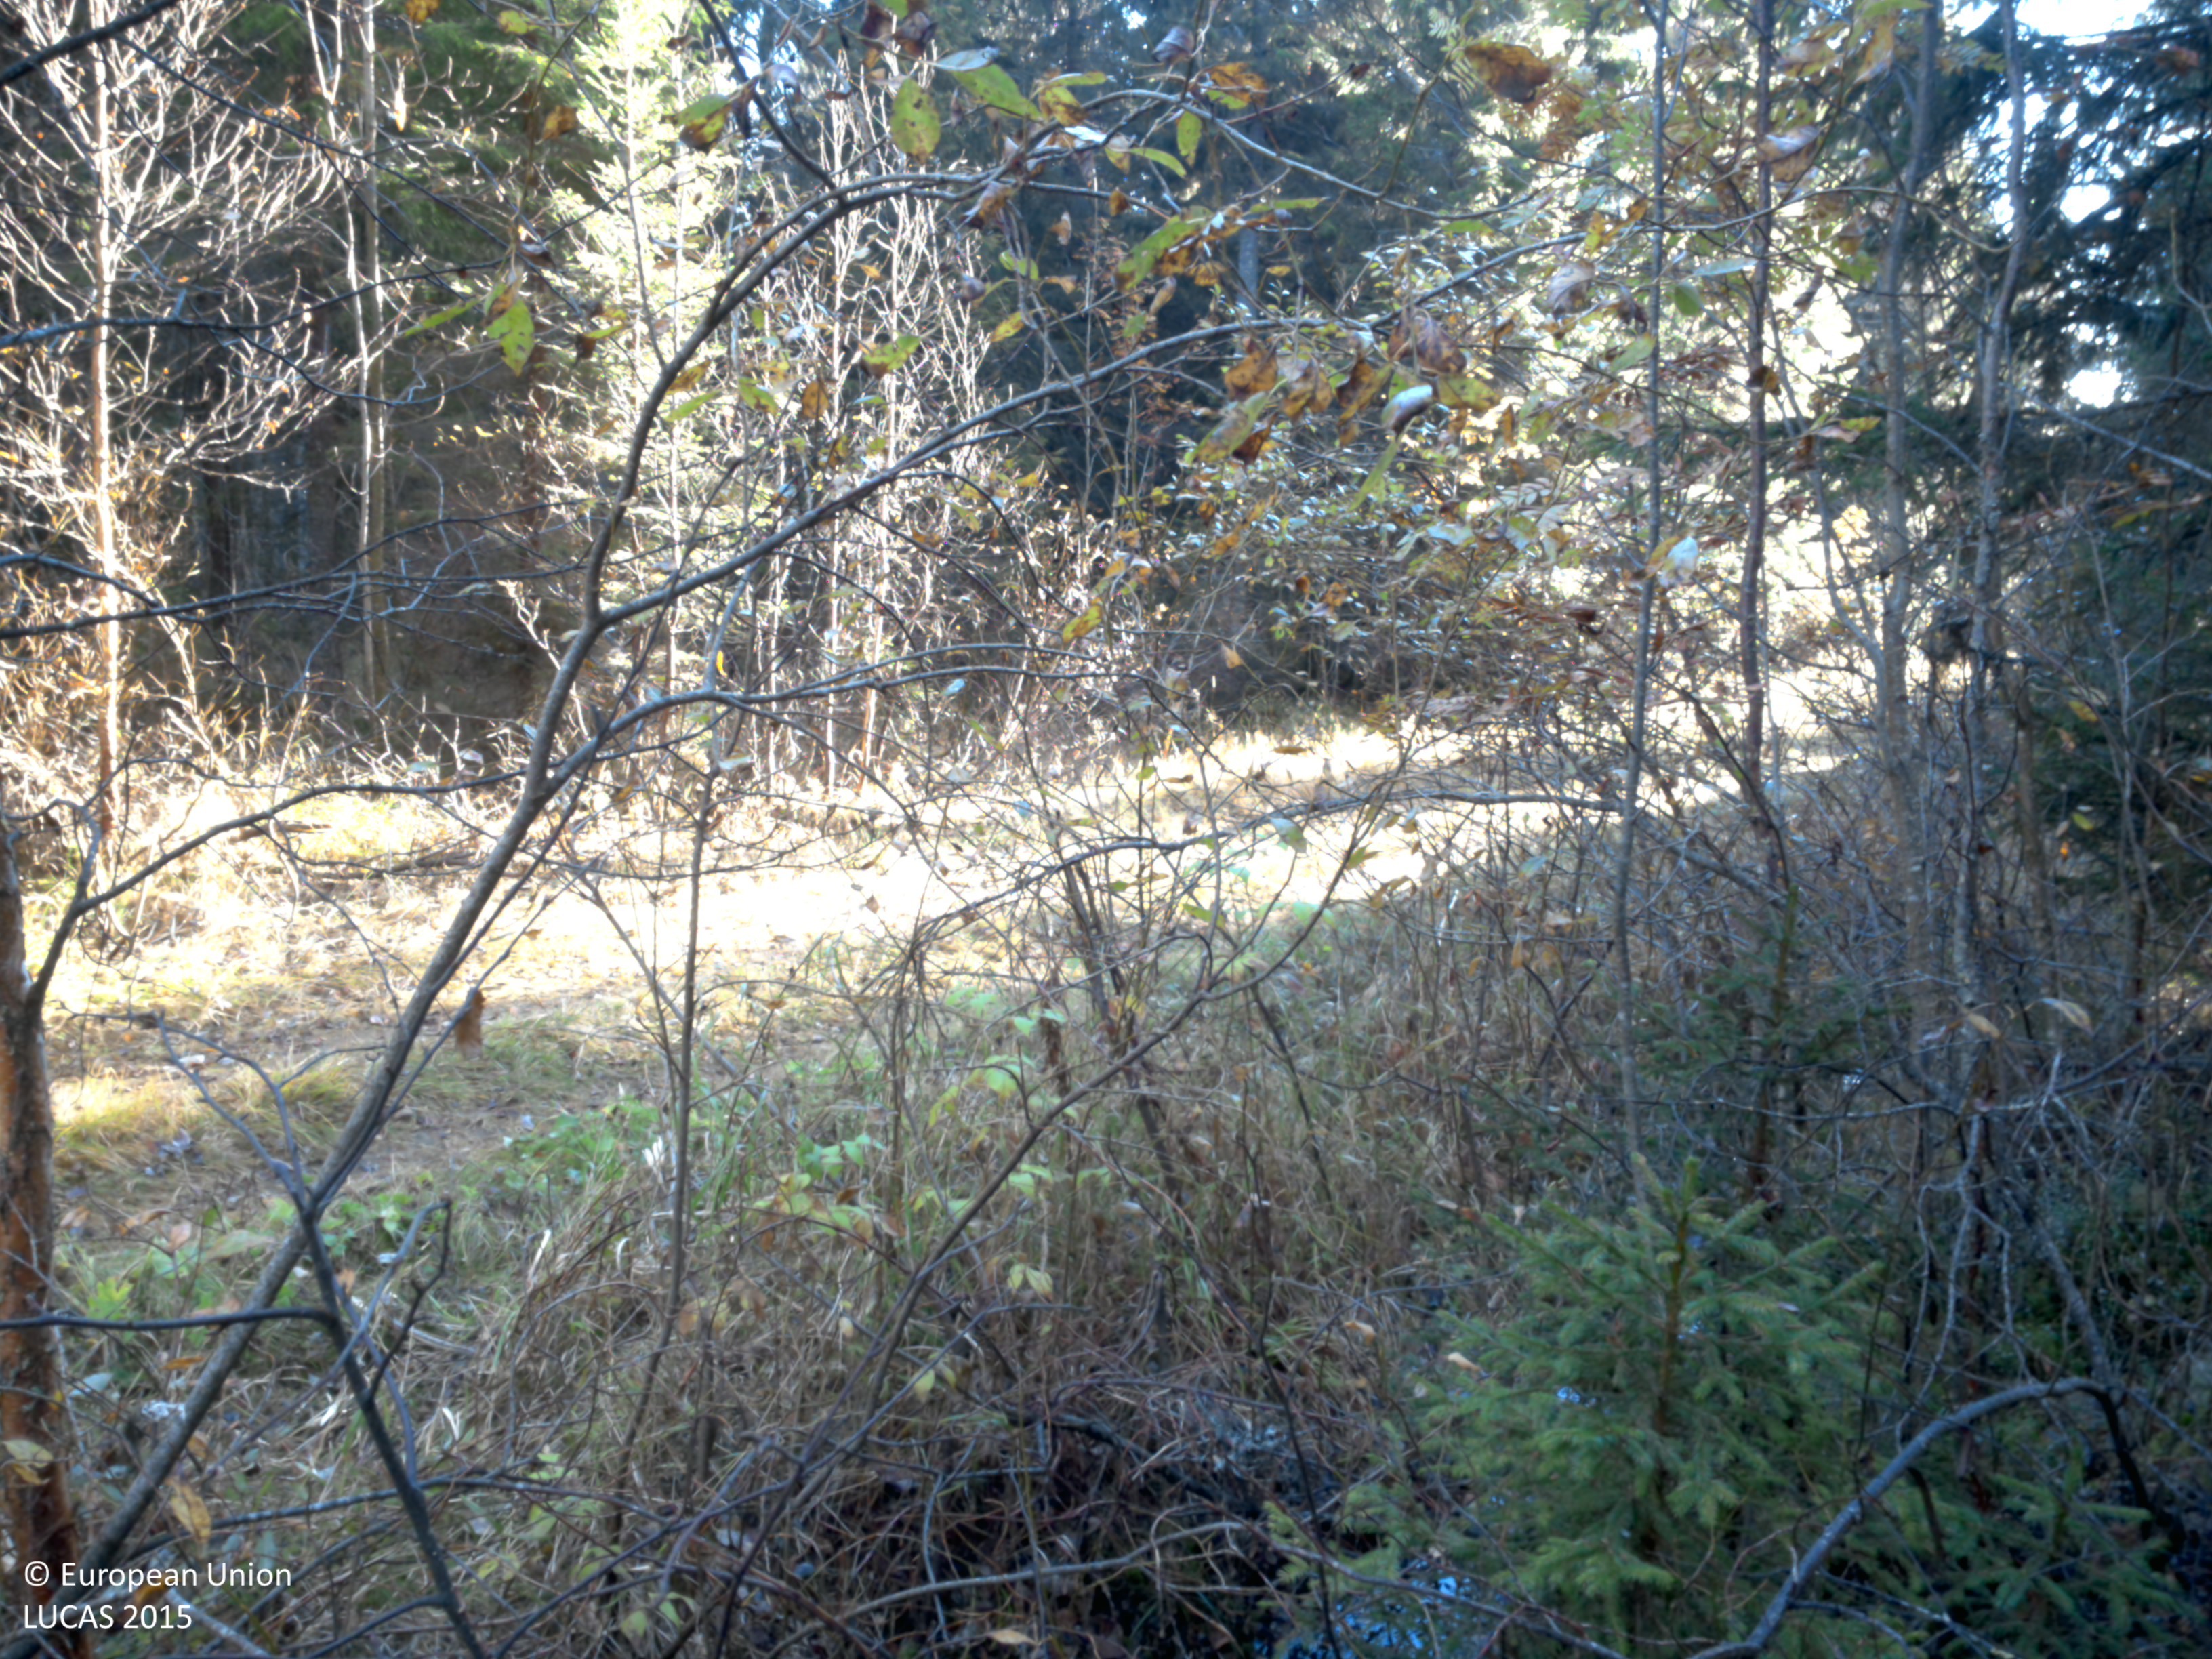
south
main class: Woodland
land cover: Other coniferous woodland
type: boreal forest
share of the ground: > 75 %
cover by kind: coniferous forest trees 80 %, shrubs 10 %, herbaceous plants 5 %, lichens and mosses 5 %
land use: Forestry
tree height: > 5 m
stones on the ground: 25 - 50 %
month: October
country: SE
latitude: 63.8747
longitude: 18.5835
